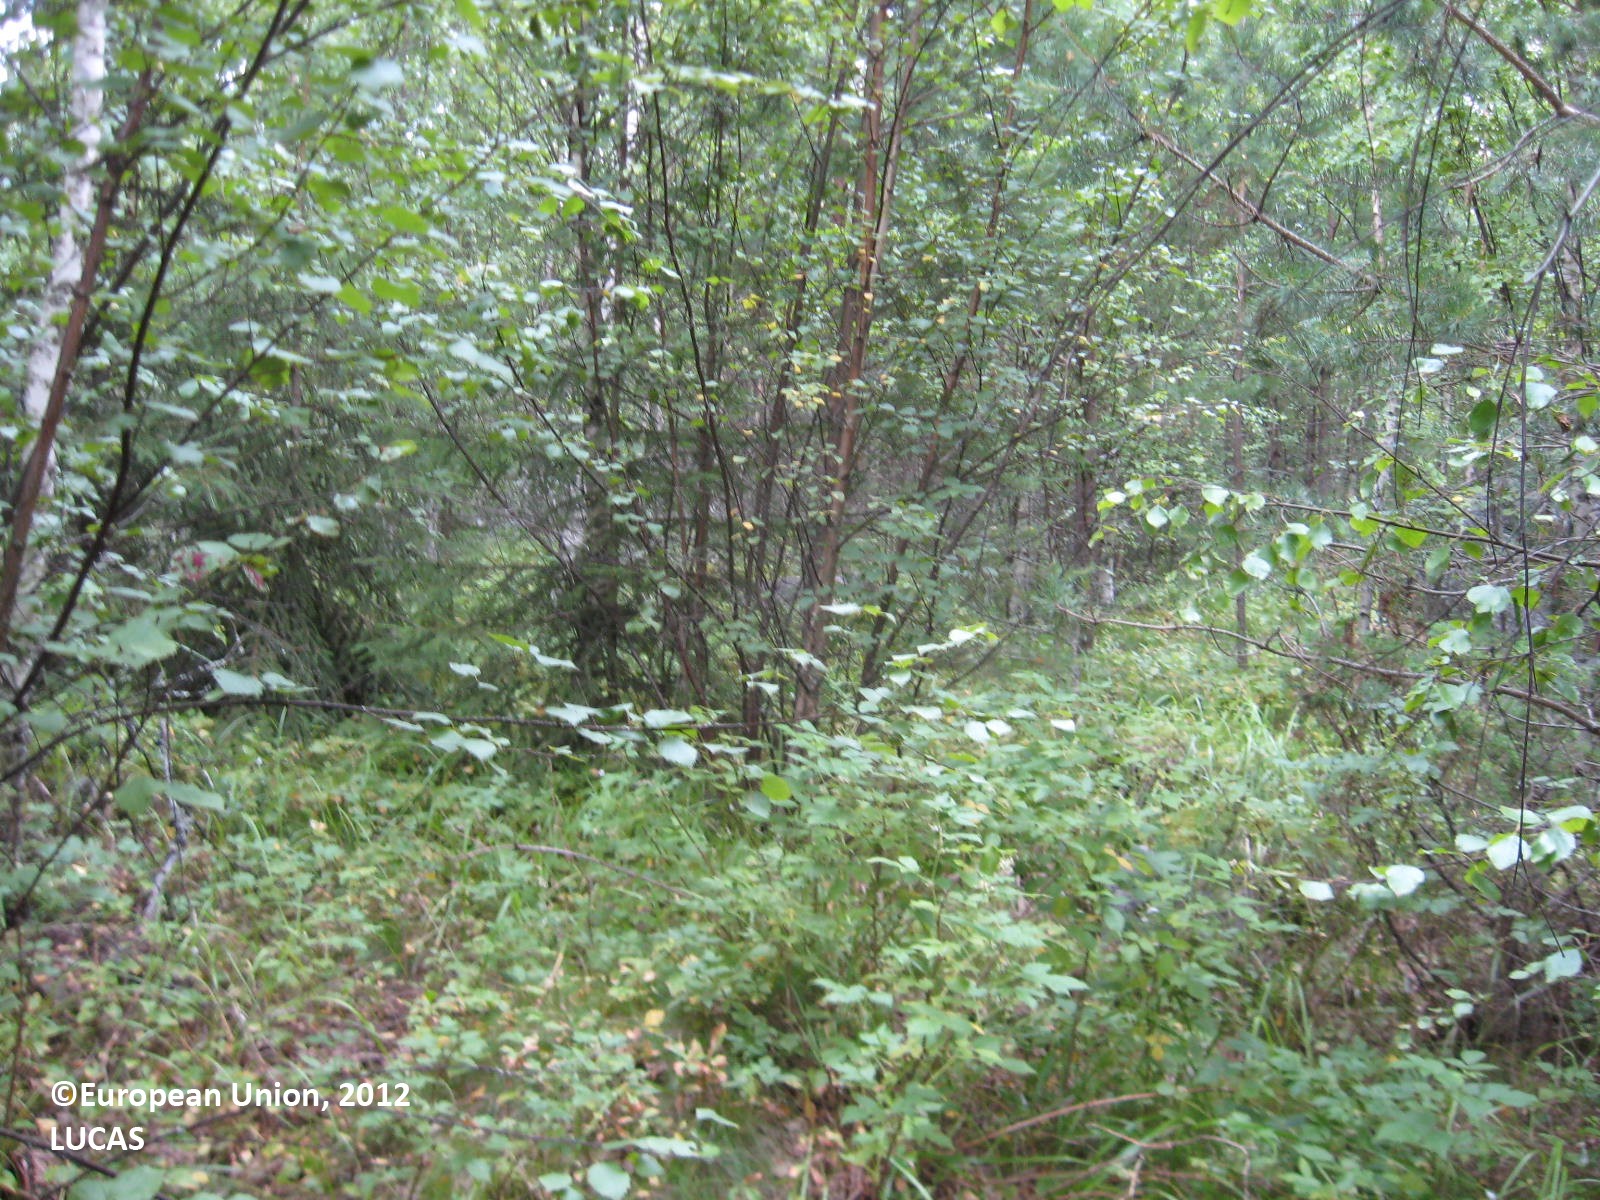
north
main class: Woodland
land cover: Other mixed woodland
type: boreal forest
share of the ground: > 75 %
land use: Forestry
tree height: > 5 m
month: July
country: FI
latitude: 61.8800
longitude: 21.4780
